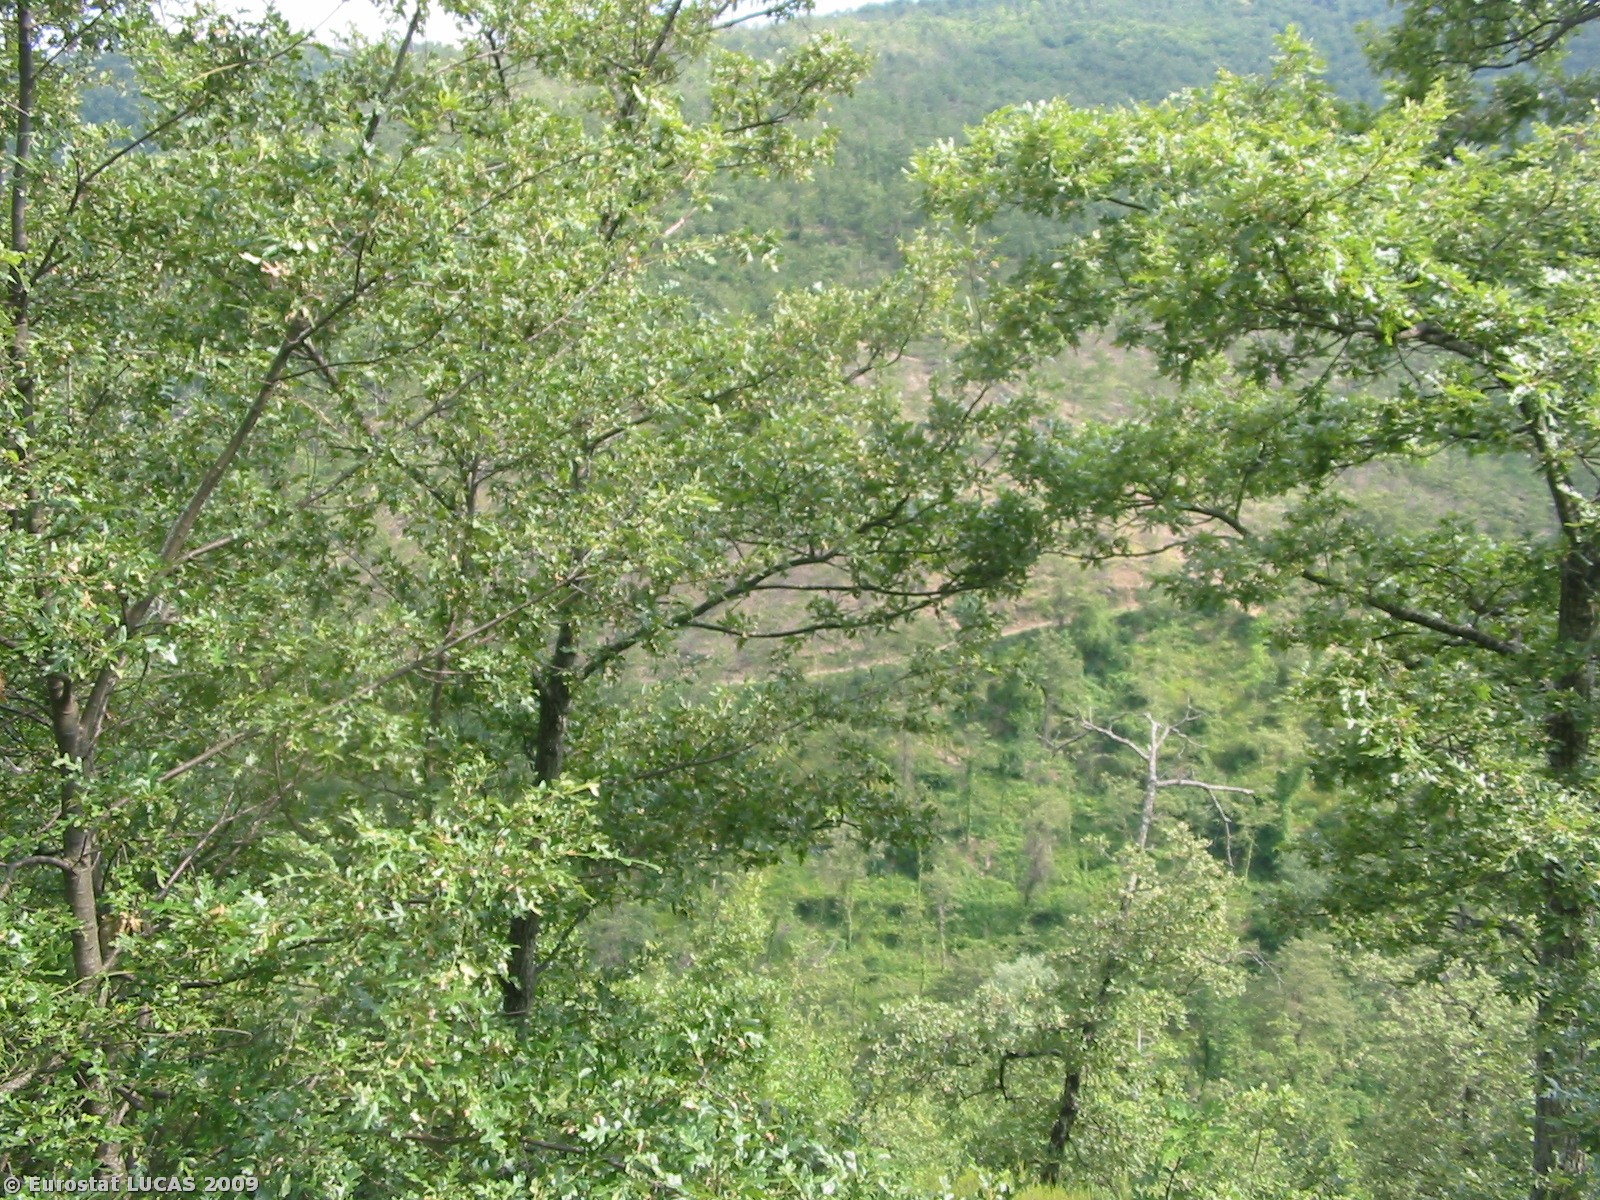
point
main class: Woodland
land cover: Broadleaved woodland
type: broadleaved evergreen forest
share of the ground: > 75 %
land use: Forestry
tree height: > 5 m
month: June
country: IT
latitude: 43.3385
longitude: 12.0049
